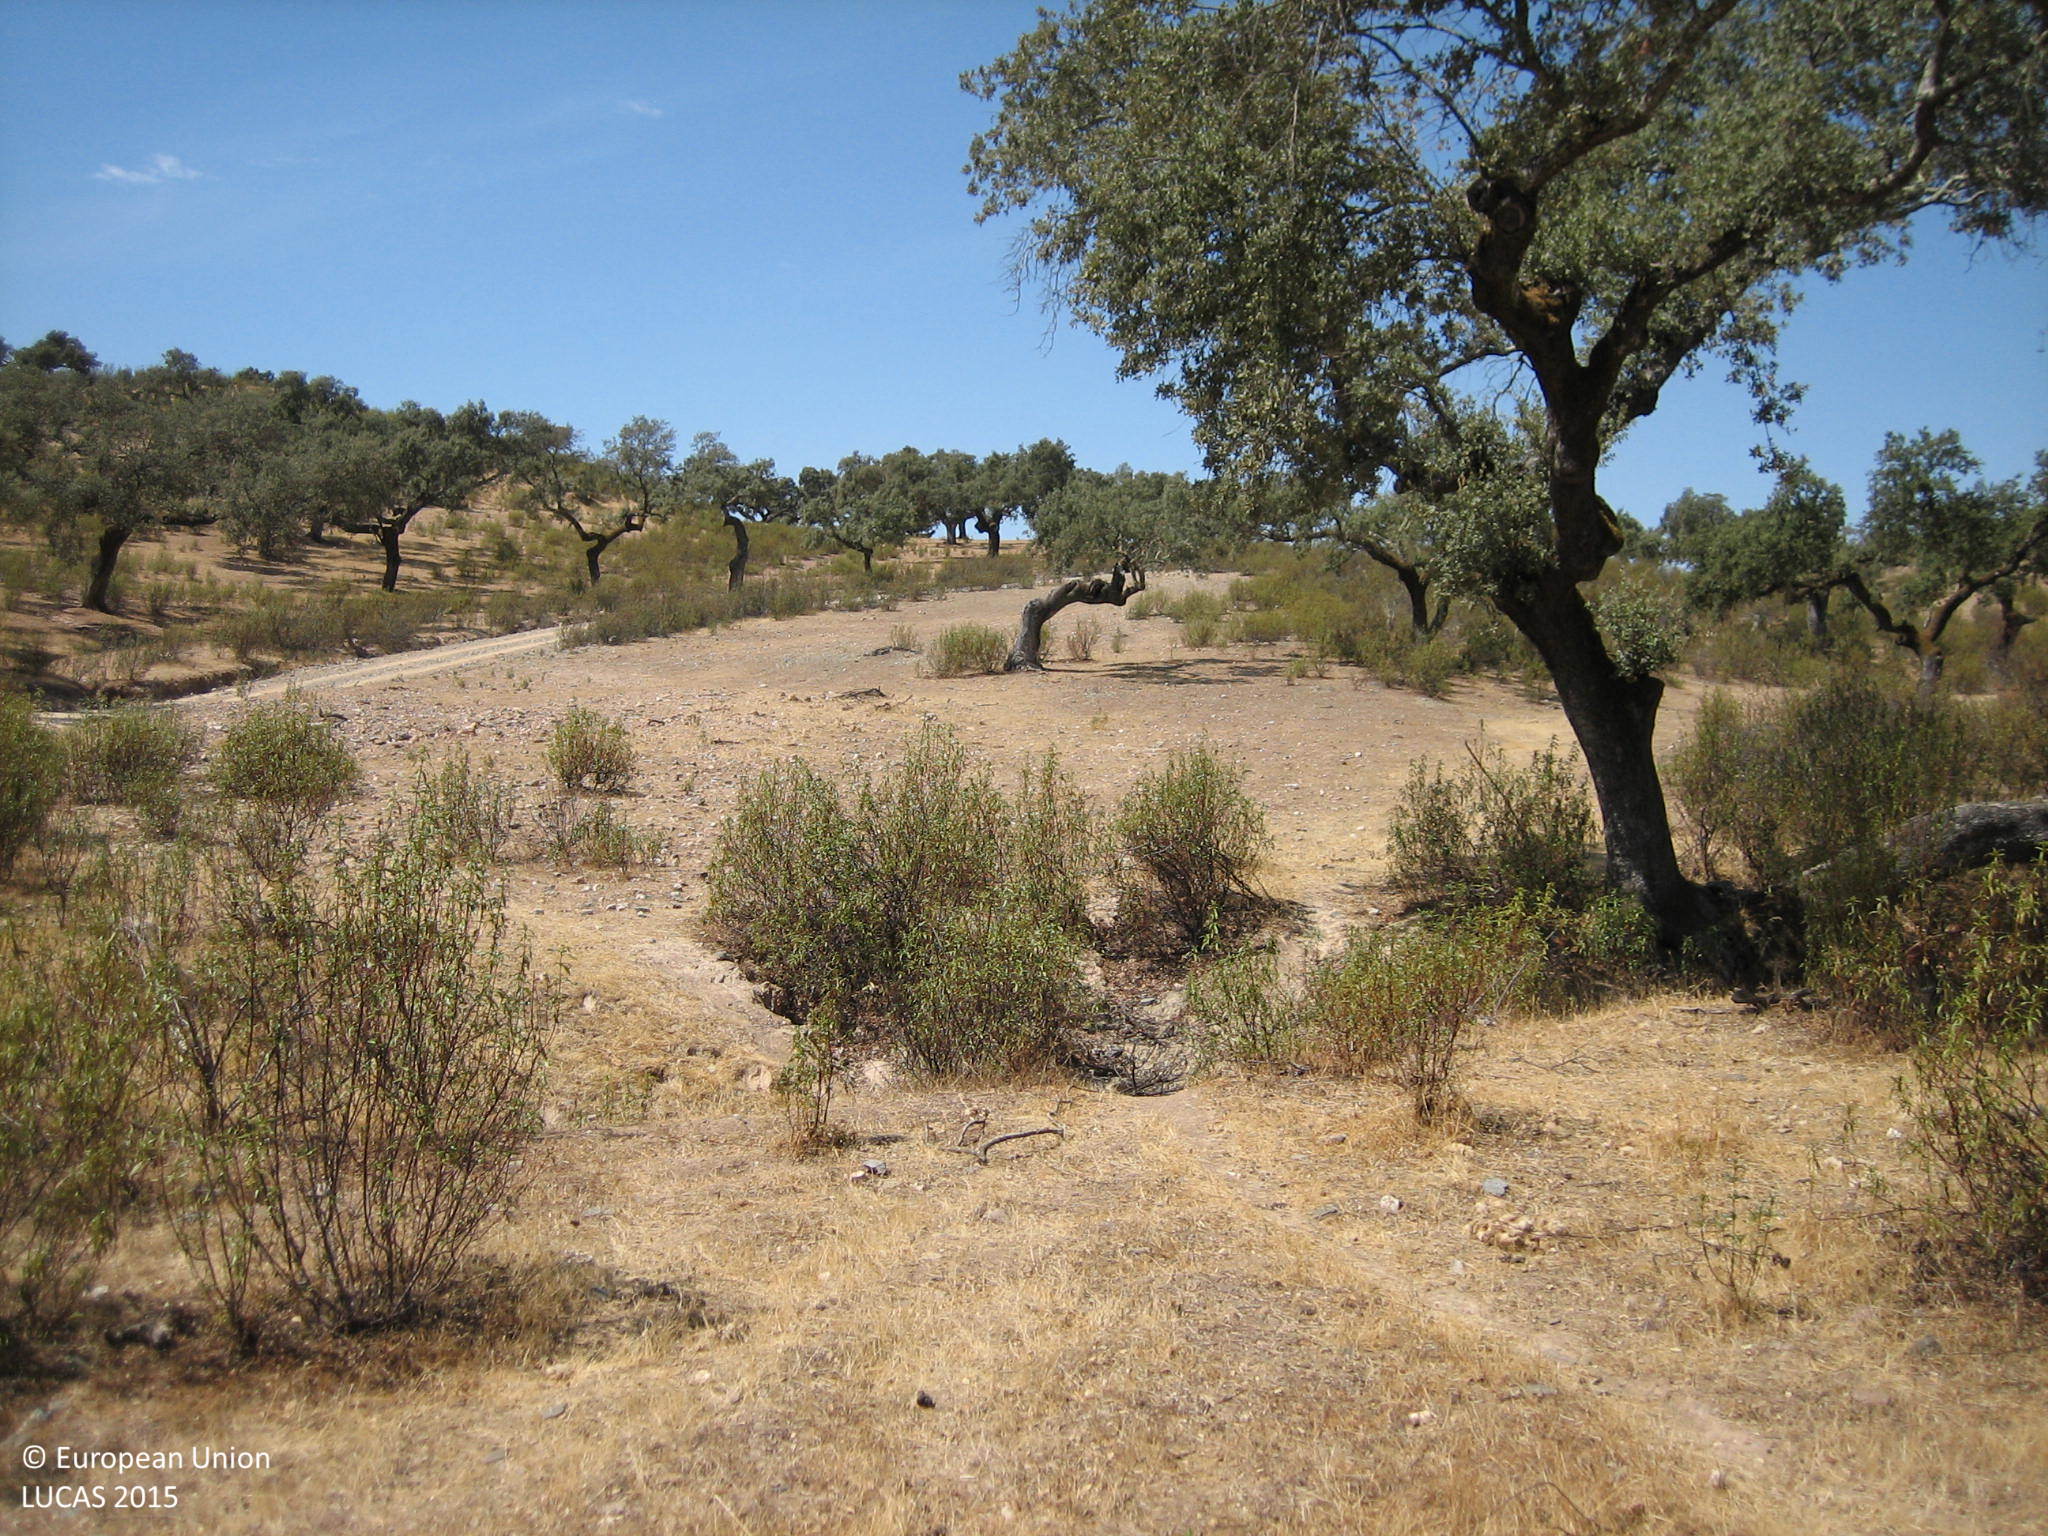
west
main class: Woodland
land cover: Broadleaved woodland
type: broadleaved evergreen forest
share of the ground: 10 - 25 %
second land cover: Grassland without tree/shrub cover
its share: 50 - 75 %
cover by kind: herbaceous plants 50 %, unconsolidated bare surface 25 %, broadleaved forest trees 20 %, shrubs 5 %
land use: Forestry
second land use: Agriculture (excluding fallow land and kitchen gardens)
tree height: > 5 m
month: September
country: ES
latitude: 38.2159
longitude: -7.1129
